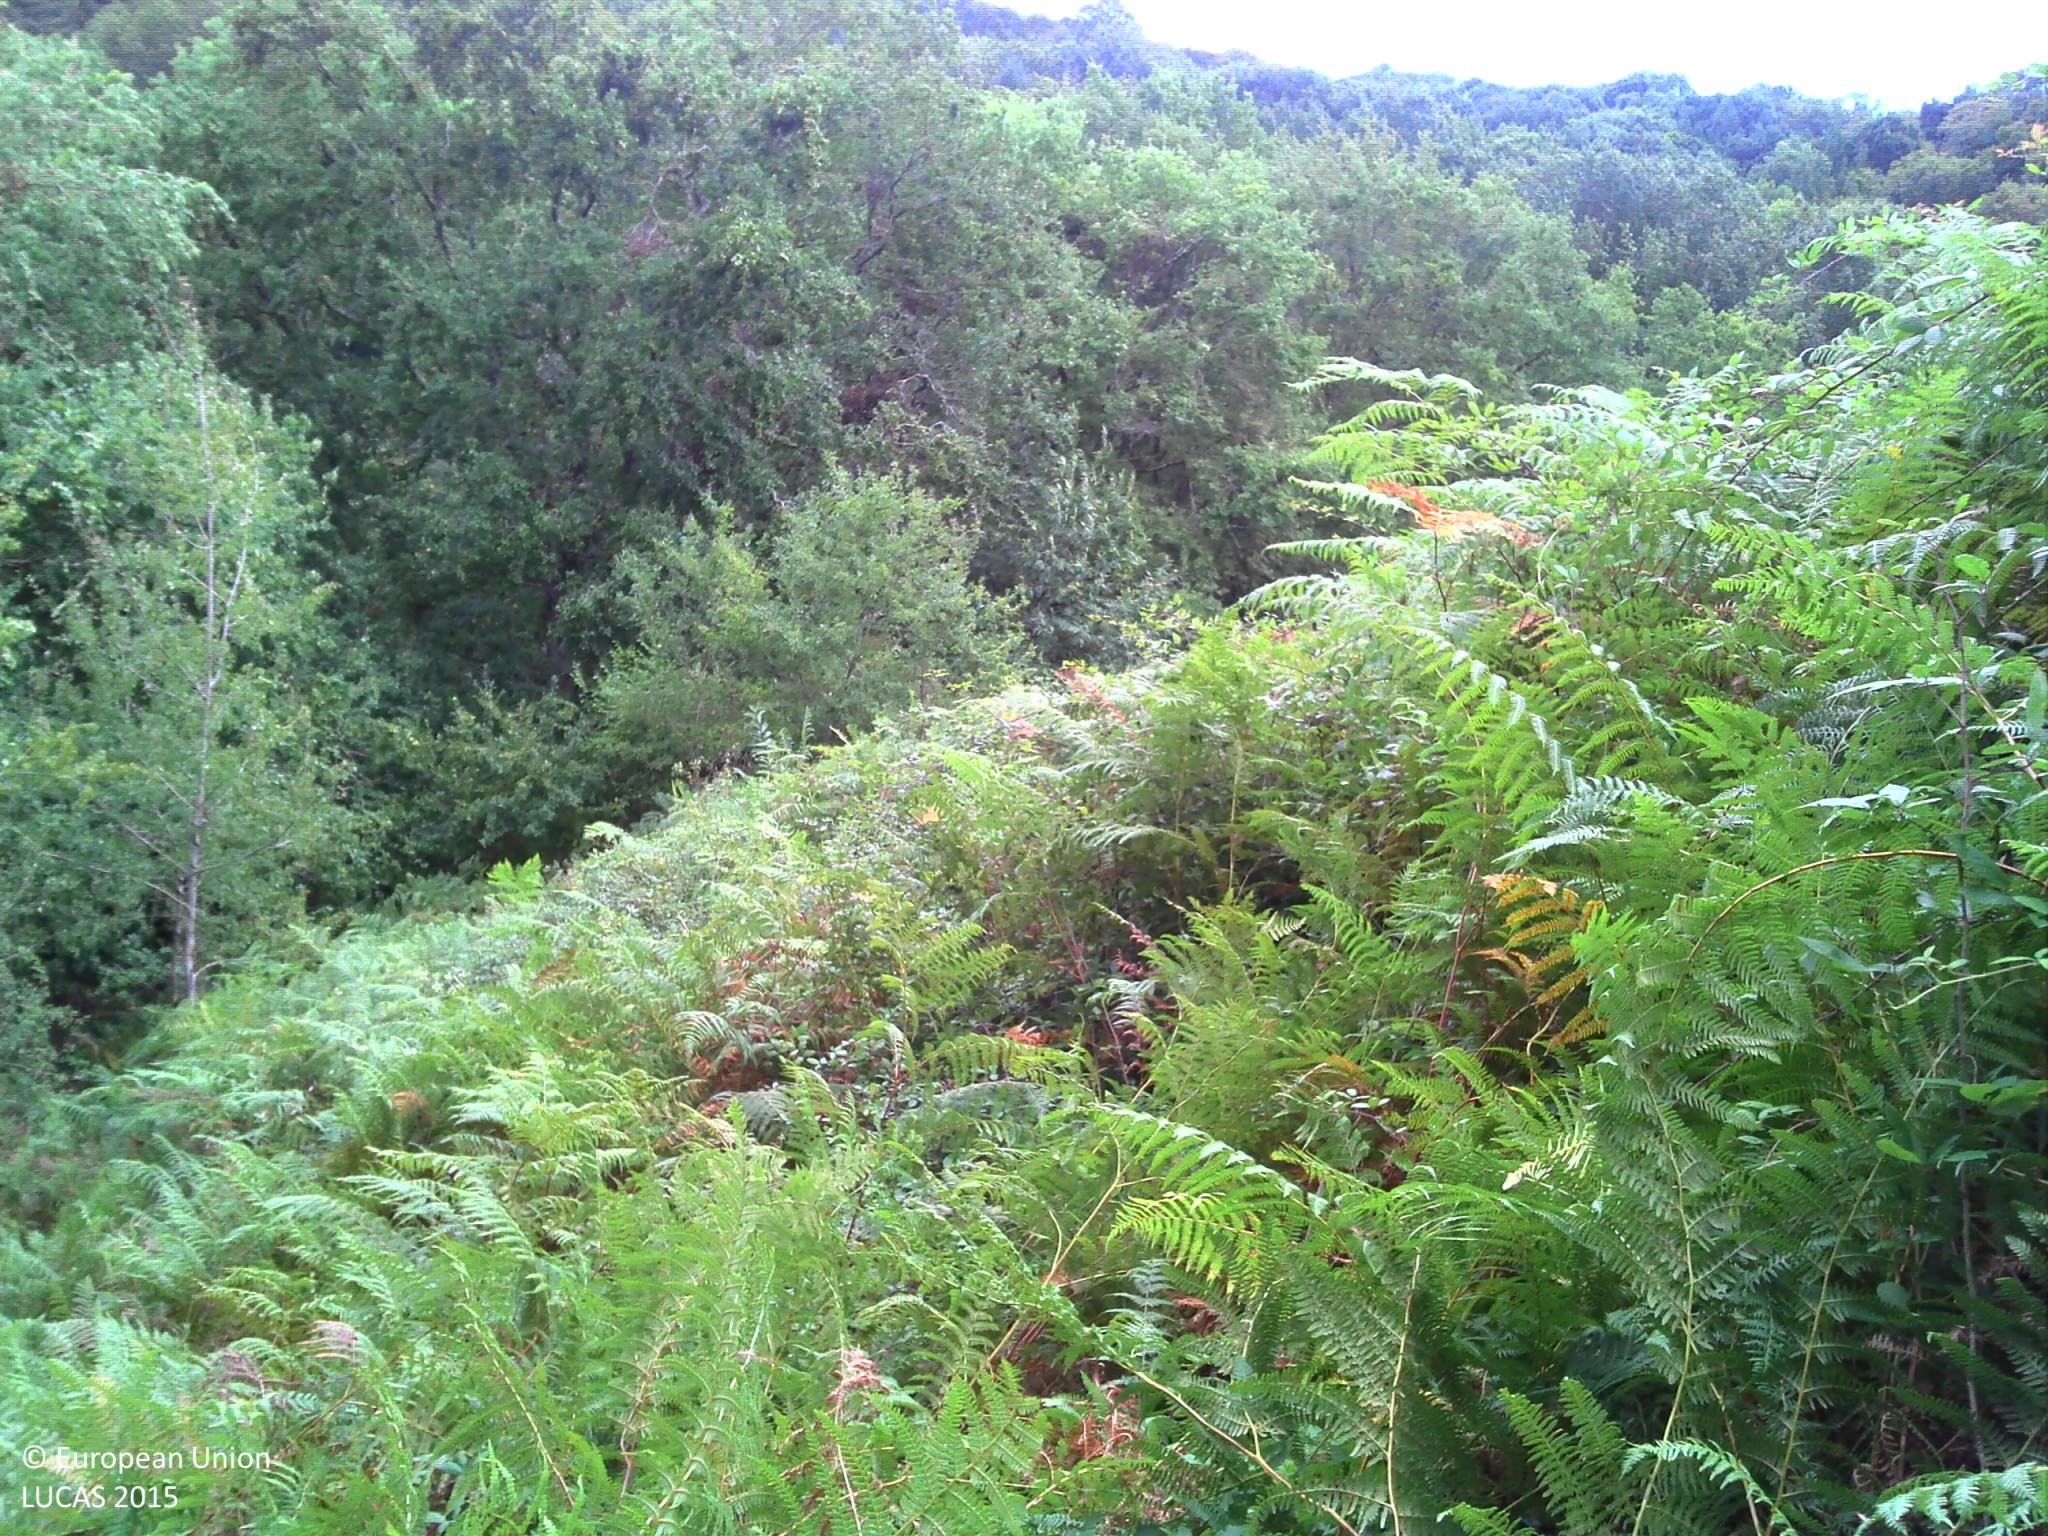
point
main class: Shrubland
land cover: Shrubland without tree cover
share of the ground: > 75 %
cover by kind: shrubs 50 %, herbaceous plants 50 %
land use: Abandoned areas
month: September
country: FR
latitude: 43.3381
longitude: -0.7288
